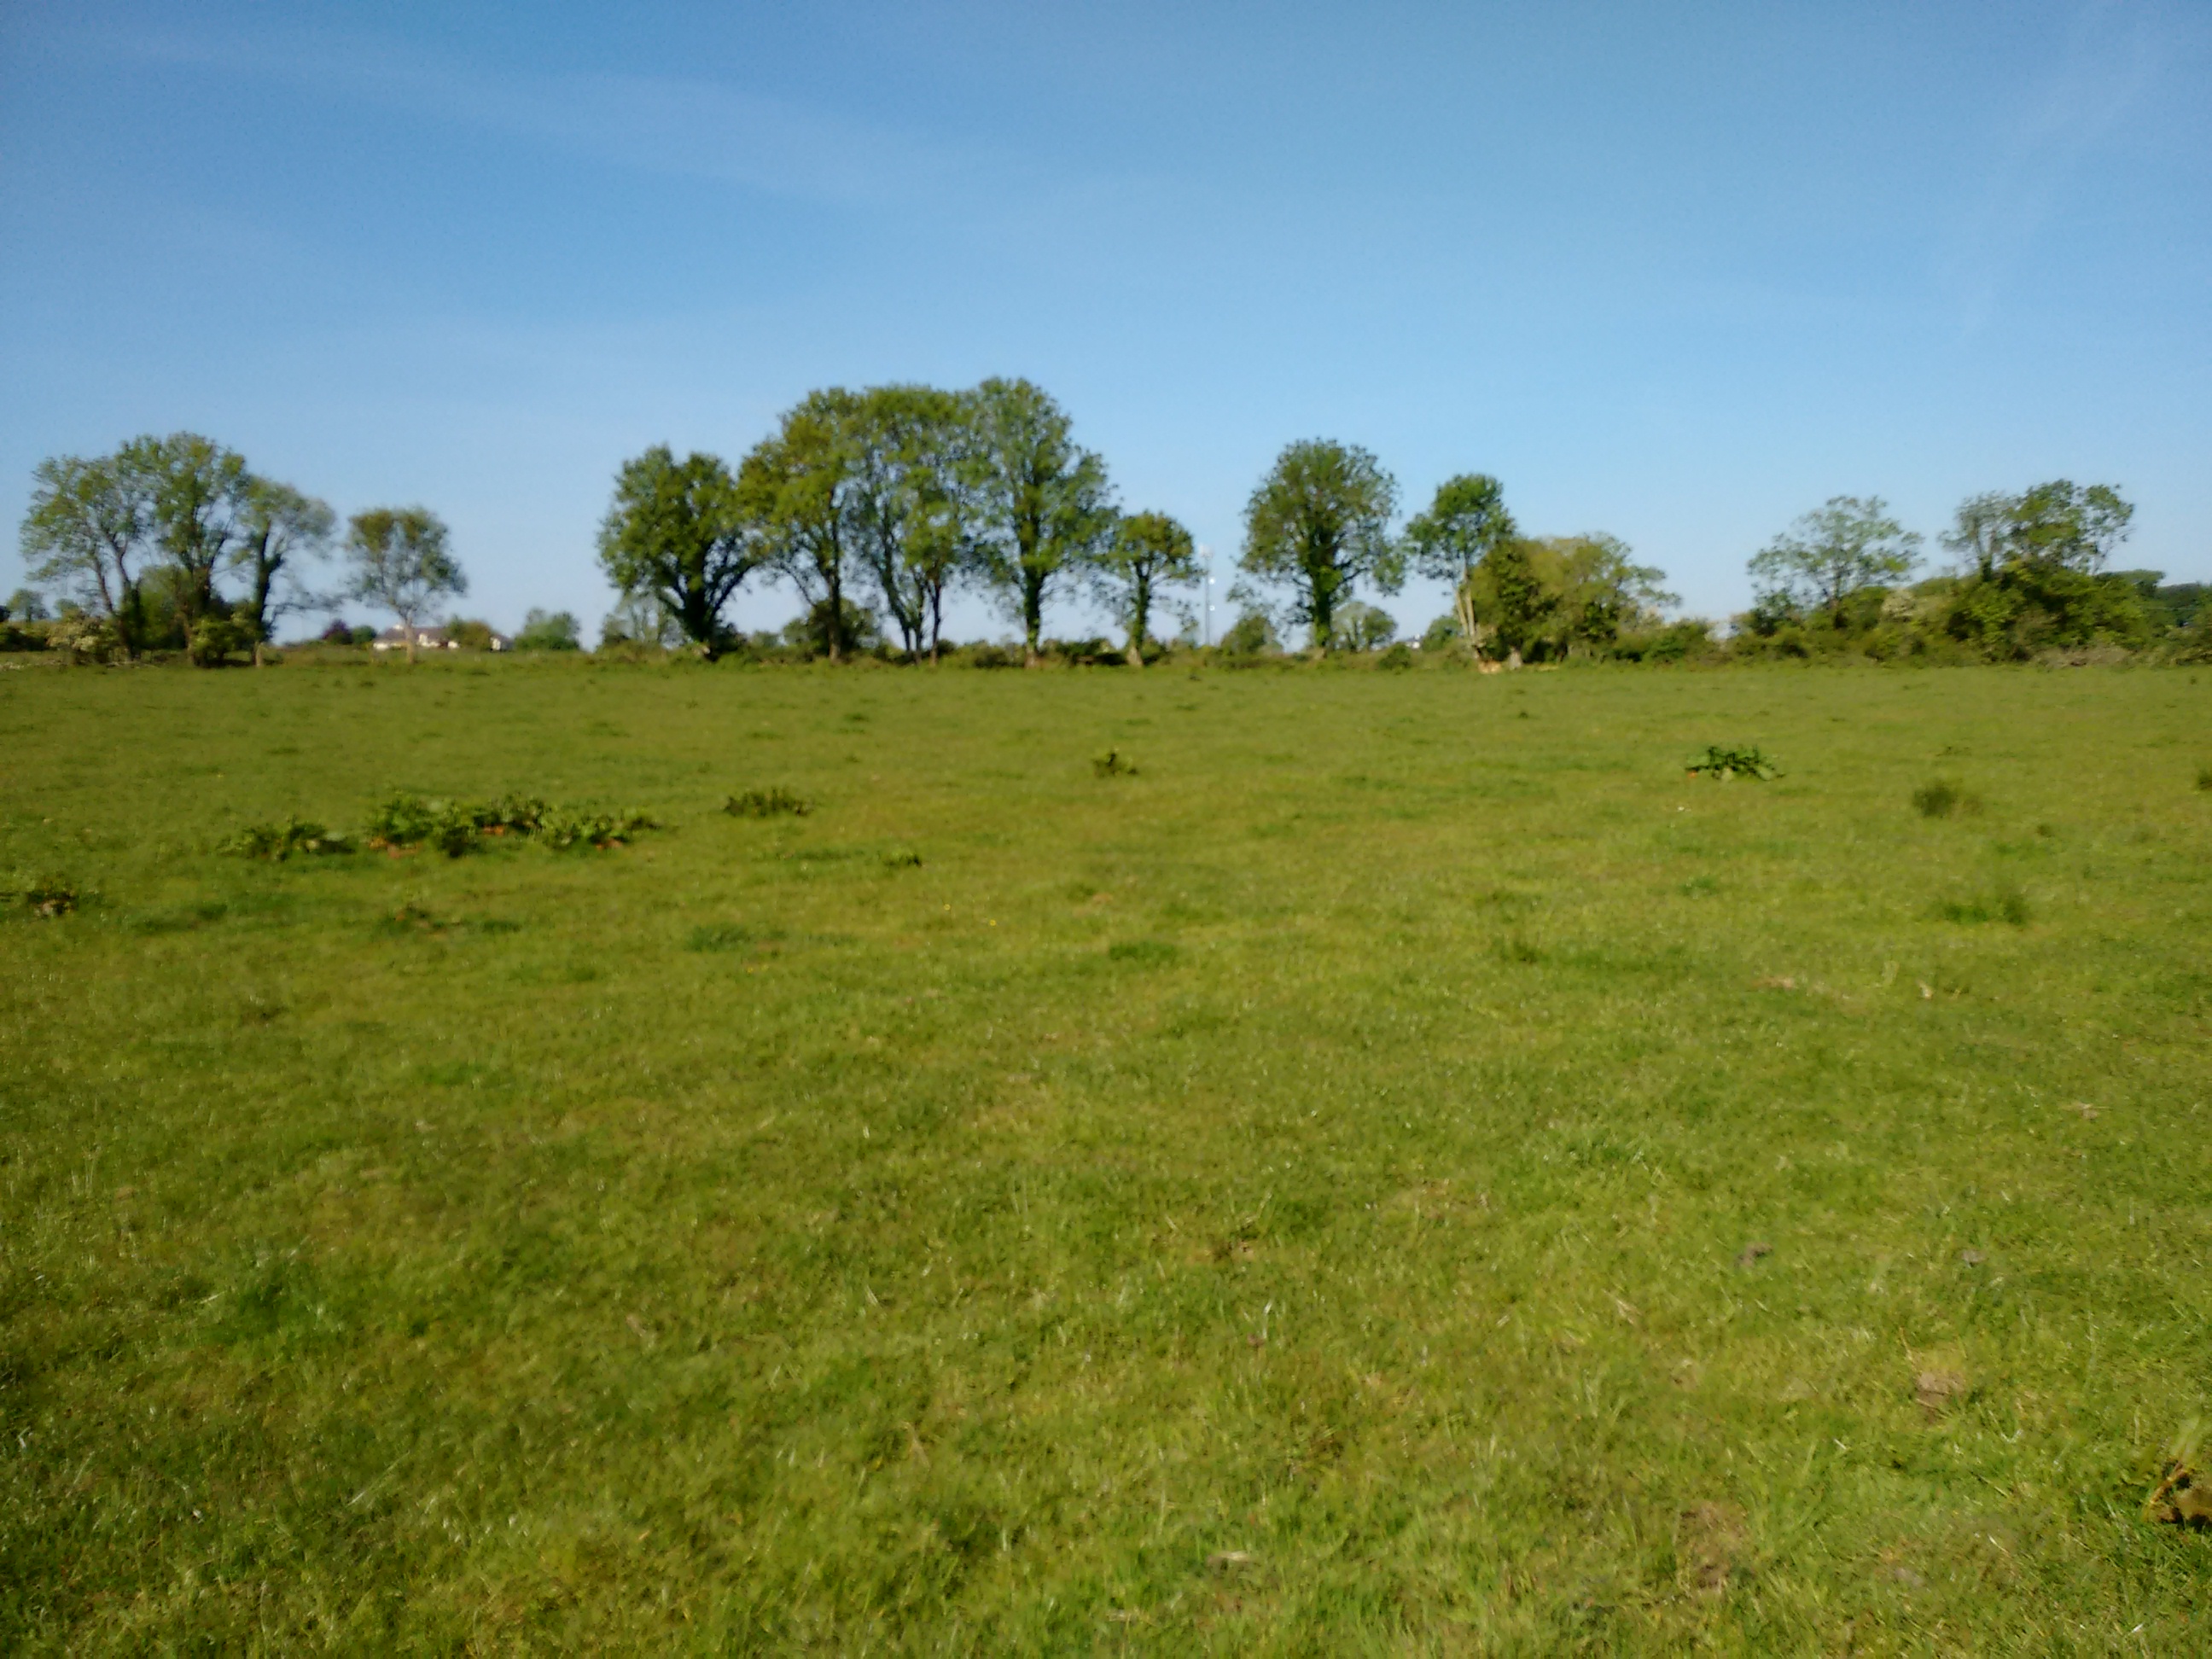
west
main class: Grassland
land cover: Grassland without tree/shrub cover
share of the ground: > 75 %
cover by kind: herbaceous plants 100 %
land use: Agriculture (excluding fallow land and kitchen gardens)
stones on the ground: < 10 %
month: June
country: IE
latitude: 53.5284
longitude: -9.0878
